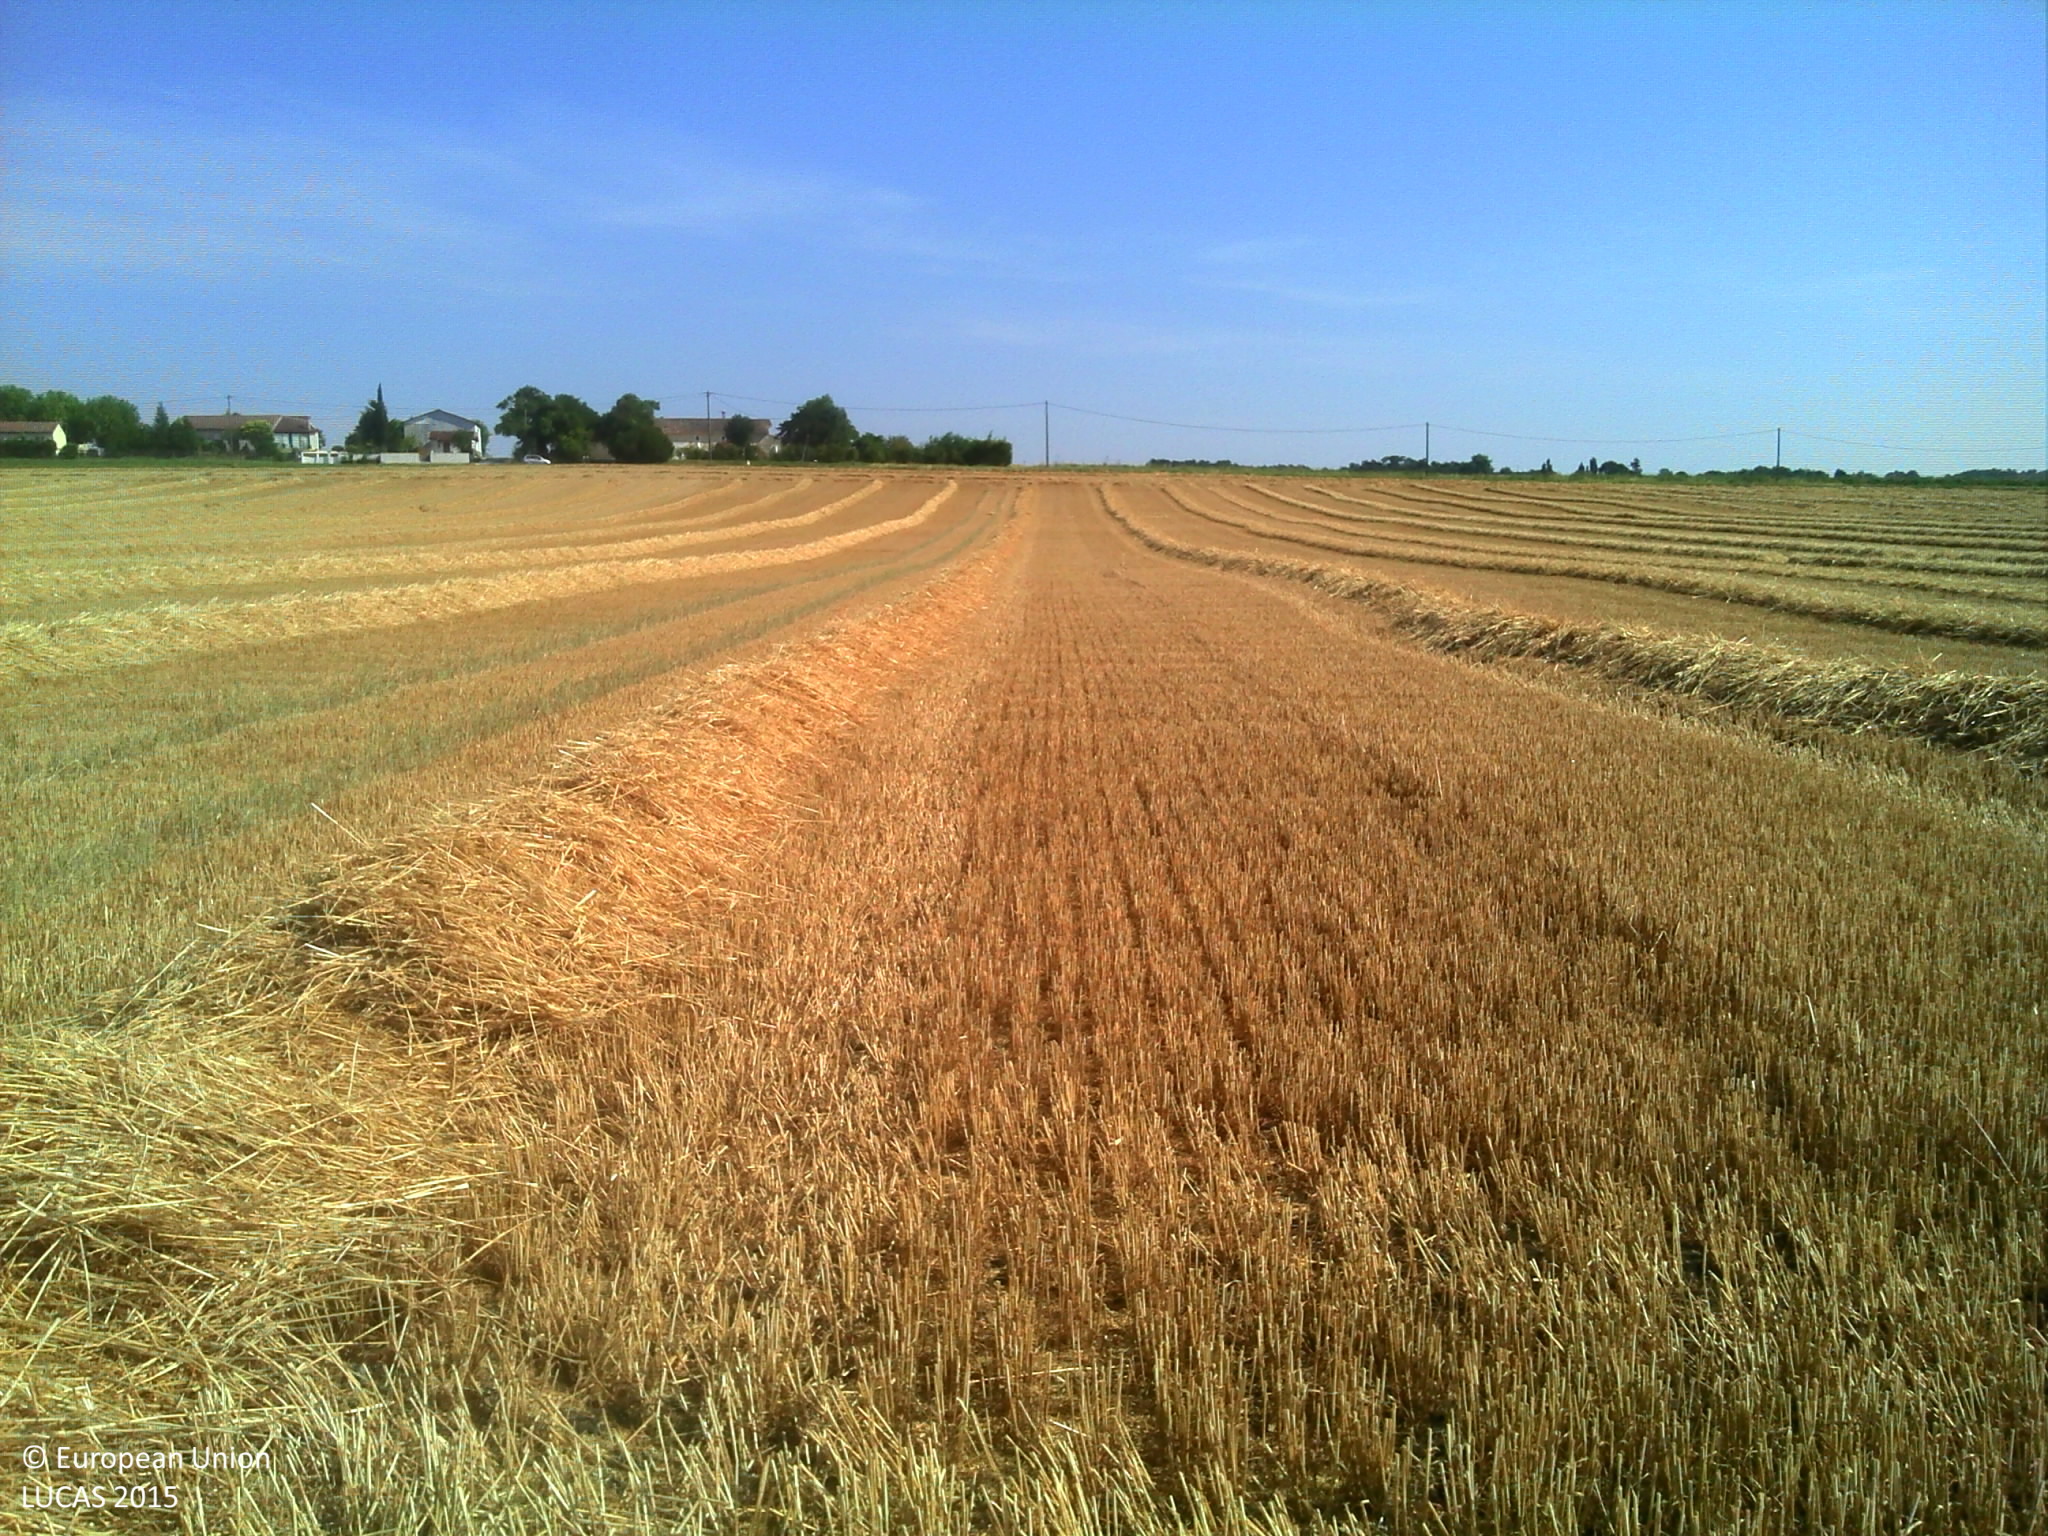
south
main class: Cropland
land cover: Common wheat
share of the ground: > 75 %
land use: Agriculture (excluding fallow land and kitchen gardens)
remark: Harvested field
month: July
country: FR
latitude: 45.3708
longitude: -0.5812
